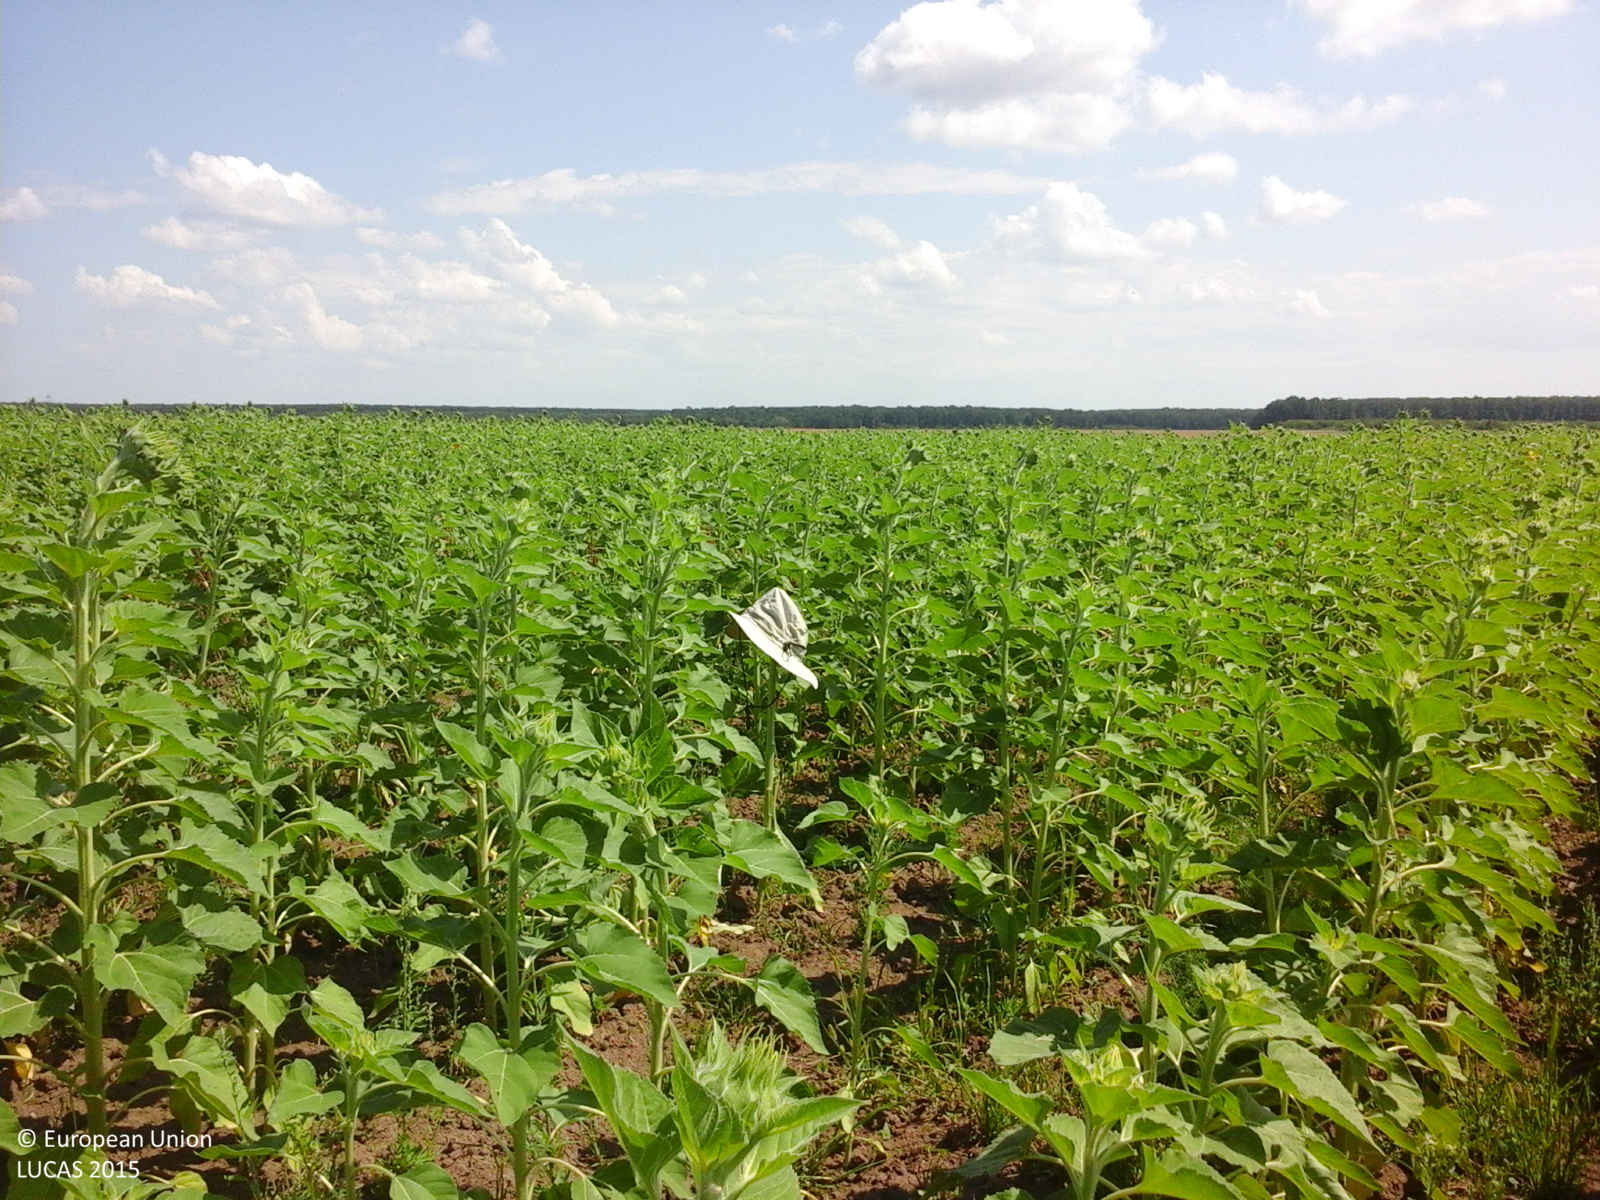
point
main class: Cropland
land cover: Sunflower
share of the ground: > 75 %
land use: Agriculture (excluding fallow land and kitchen gardens)
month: July
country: RO
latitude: 44.2283
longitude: 25.2185
